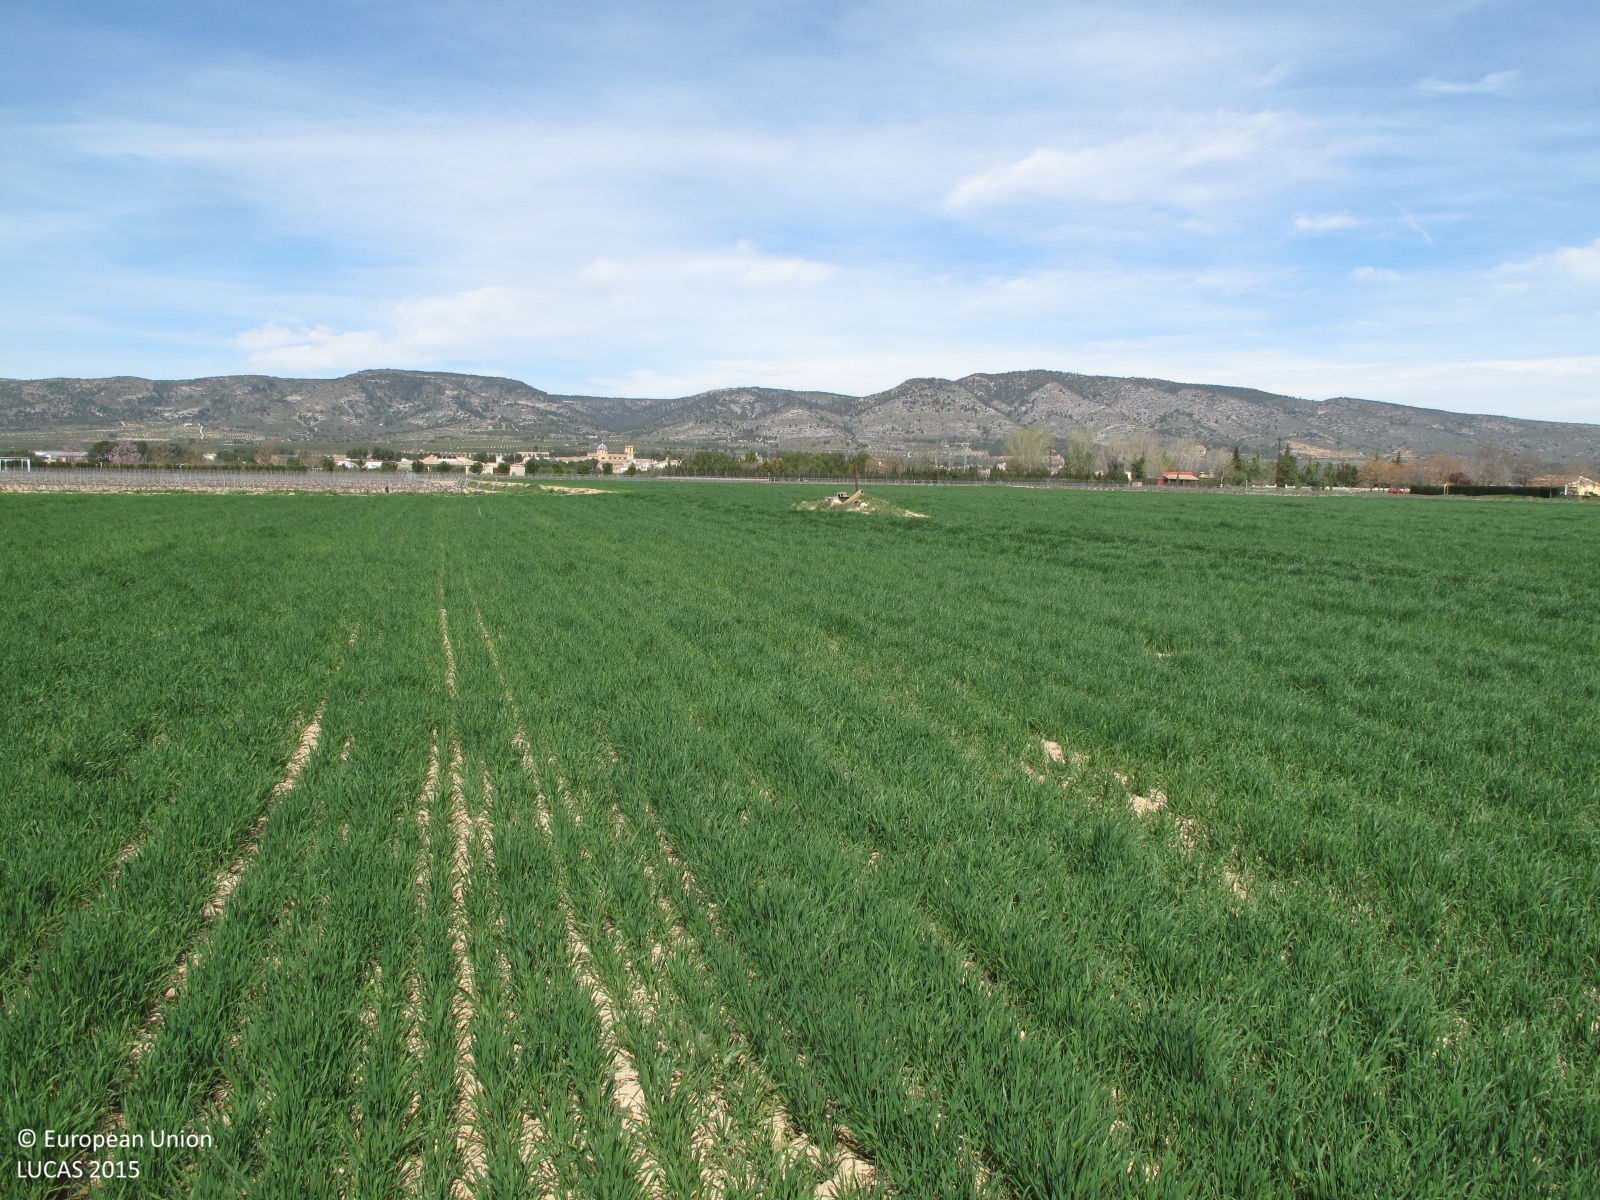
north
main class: Cropland
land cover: Barley
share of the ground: > 75 %
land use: Agriculture (excluding fallow land and kitchen gardens)
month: March
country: ES
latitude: 38.6880
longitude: -0.7625
